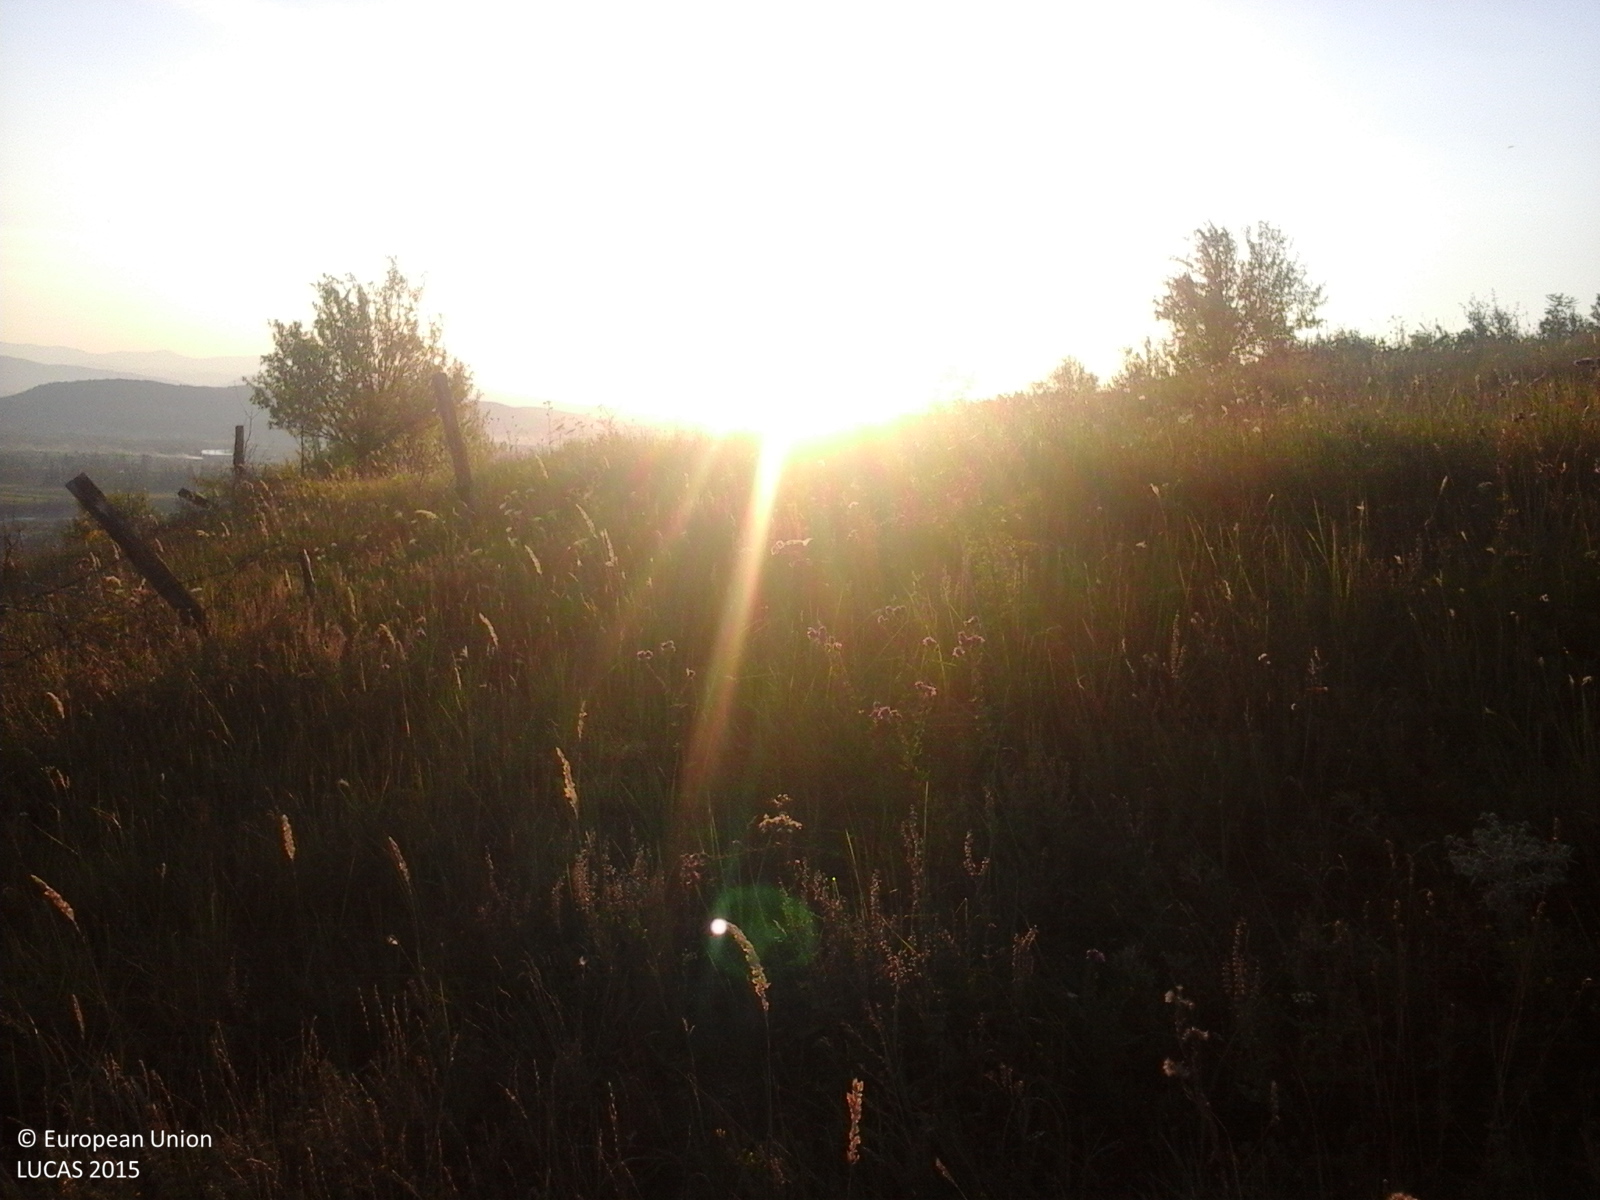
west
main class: Grassland
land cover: Grassland with sparse tree/shrub cover
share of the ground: > 75 %
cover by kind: herbaceous plants 85 %, shrubs 10 %, broadleaved forest trees 5 %
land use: Agriculture (excluding fallow land and kitchen gardens)
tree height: < 5 m
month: August
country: RO
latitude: 46.2719
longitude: 26.8419
